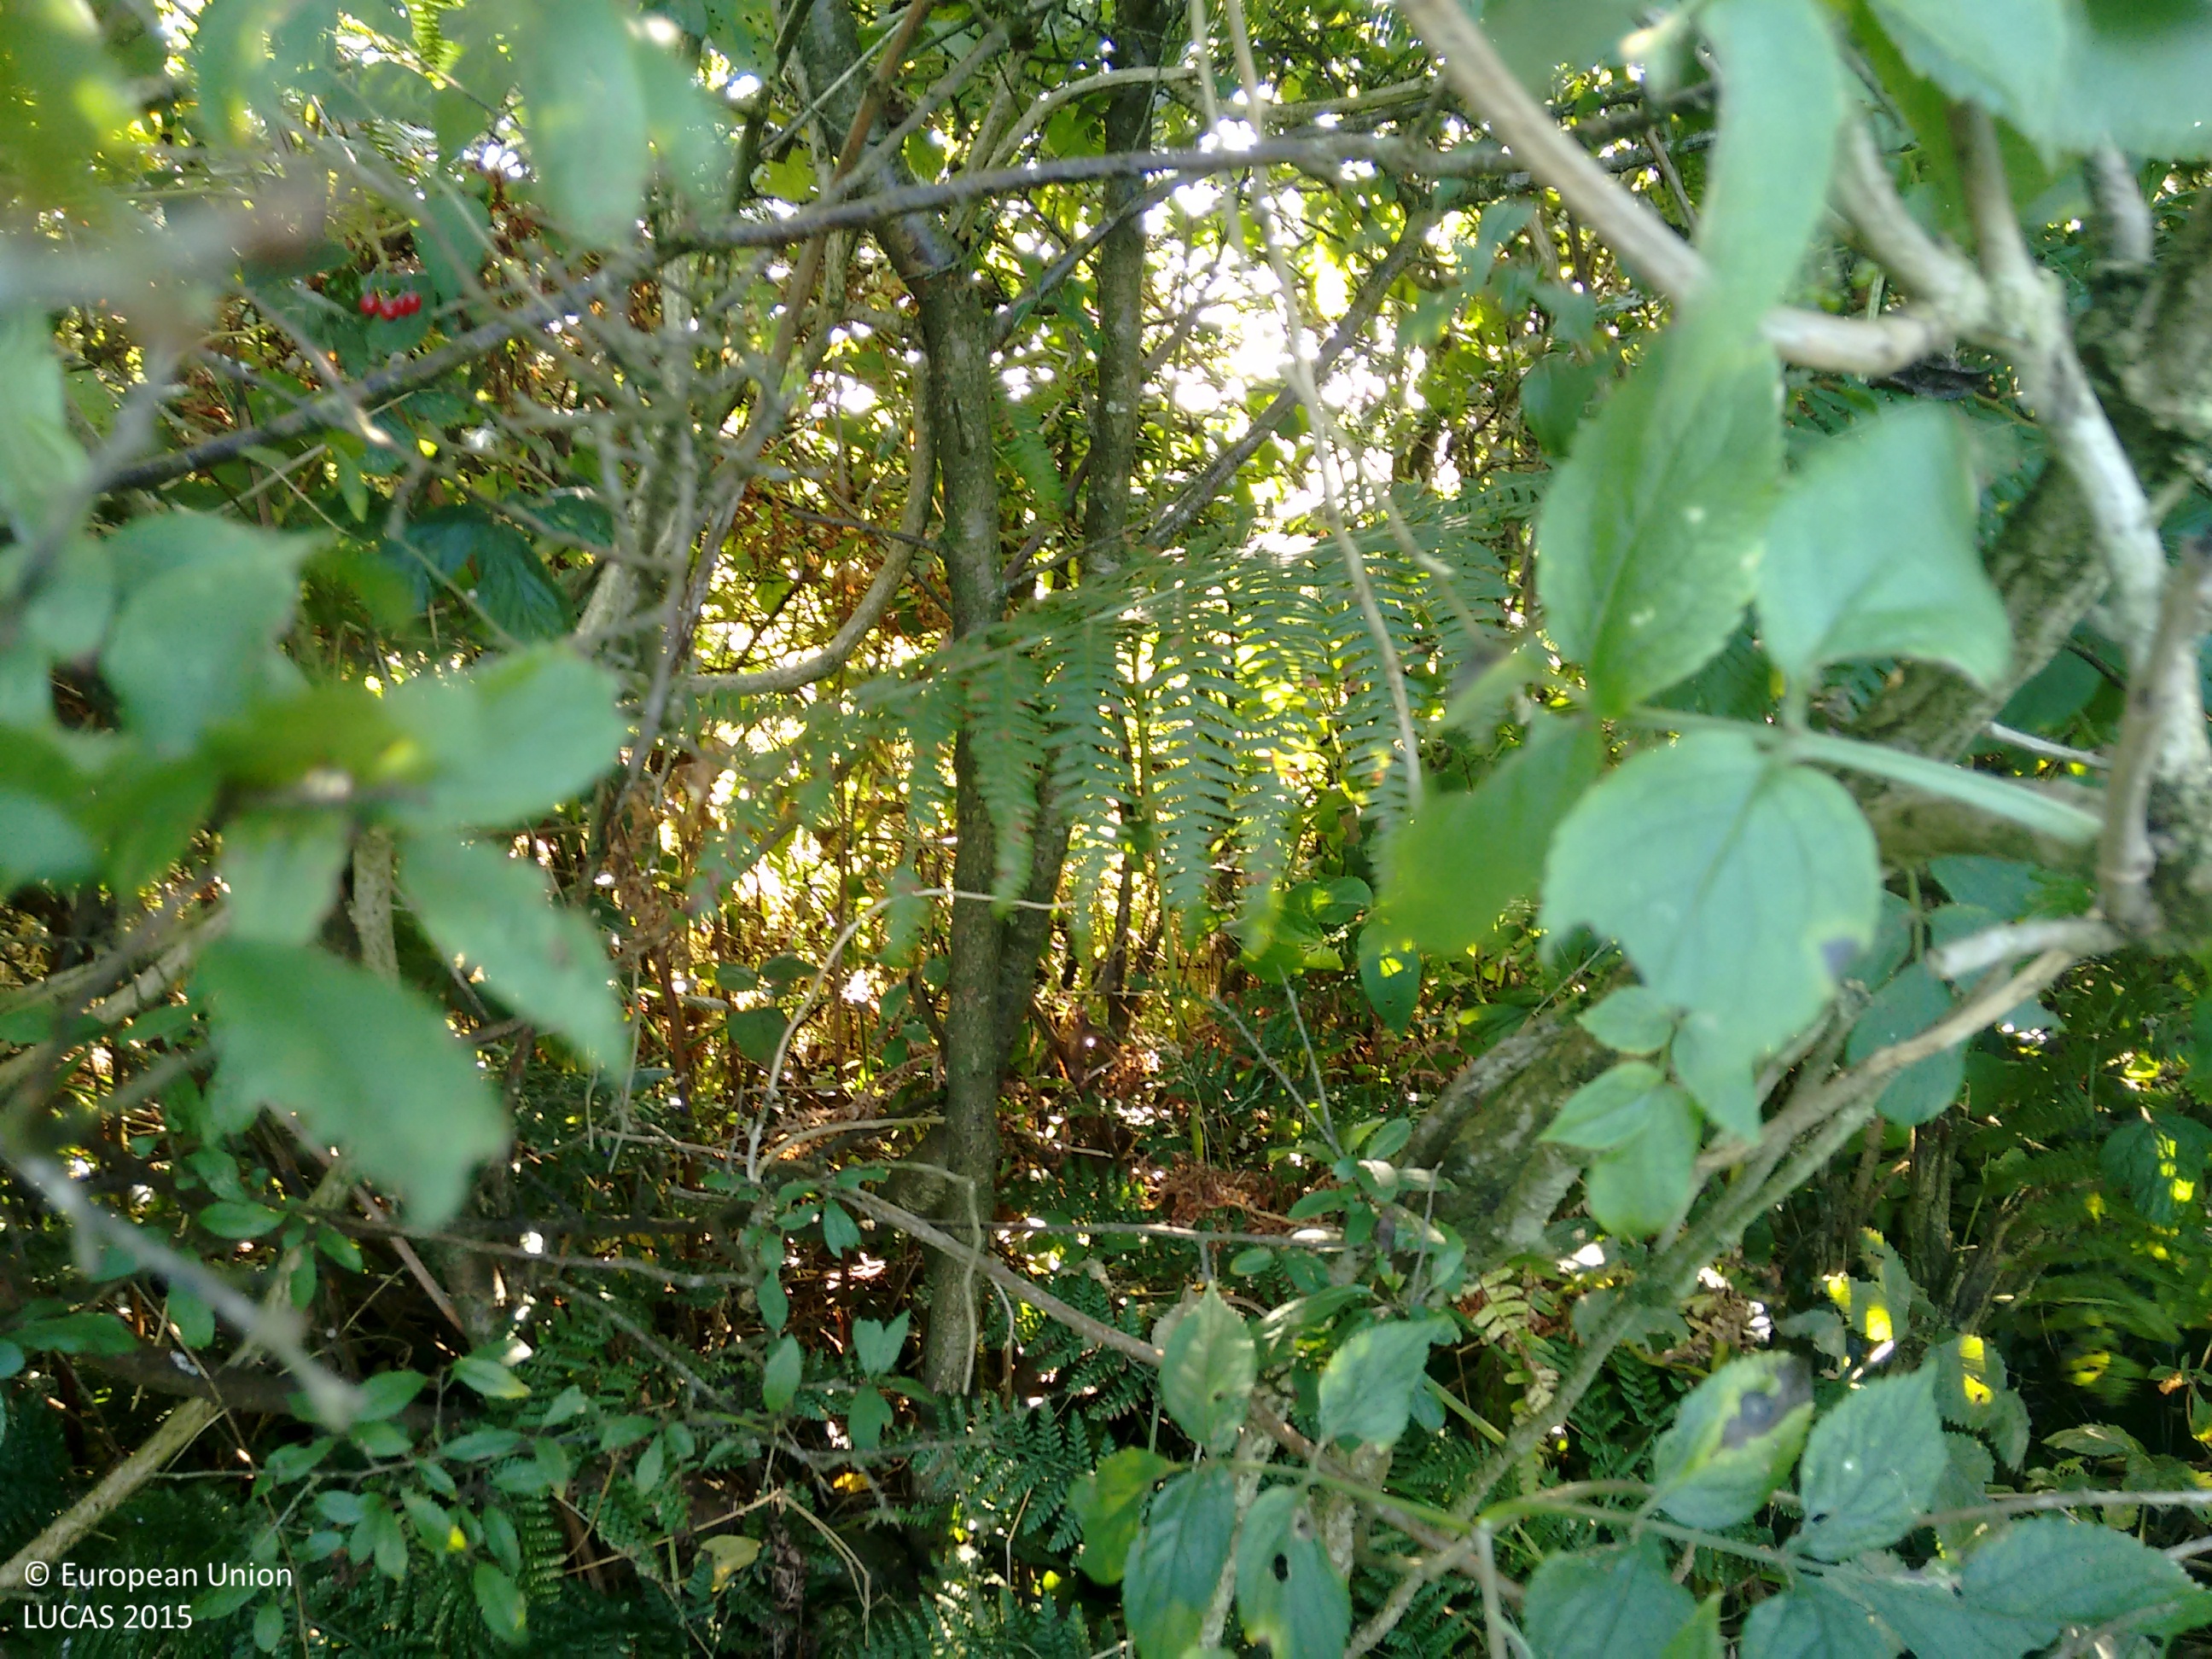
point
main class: Grassland
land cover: Grassland without tree/shrub cover
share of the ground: > 75 %
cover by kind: herbaceous plants 100 %
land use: Agriculture (excluding fallow land and kitchen gardens)
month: September
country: GB
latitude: 50.8879
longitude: -4.4180
